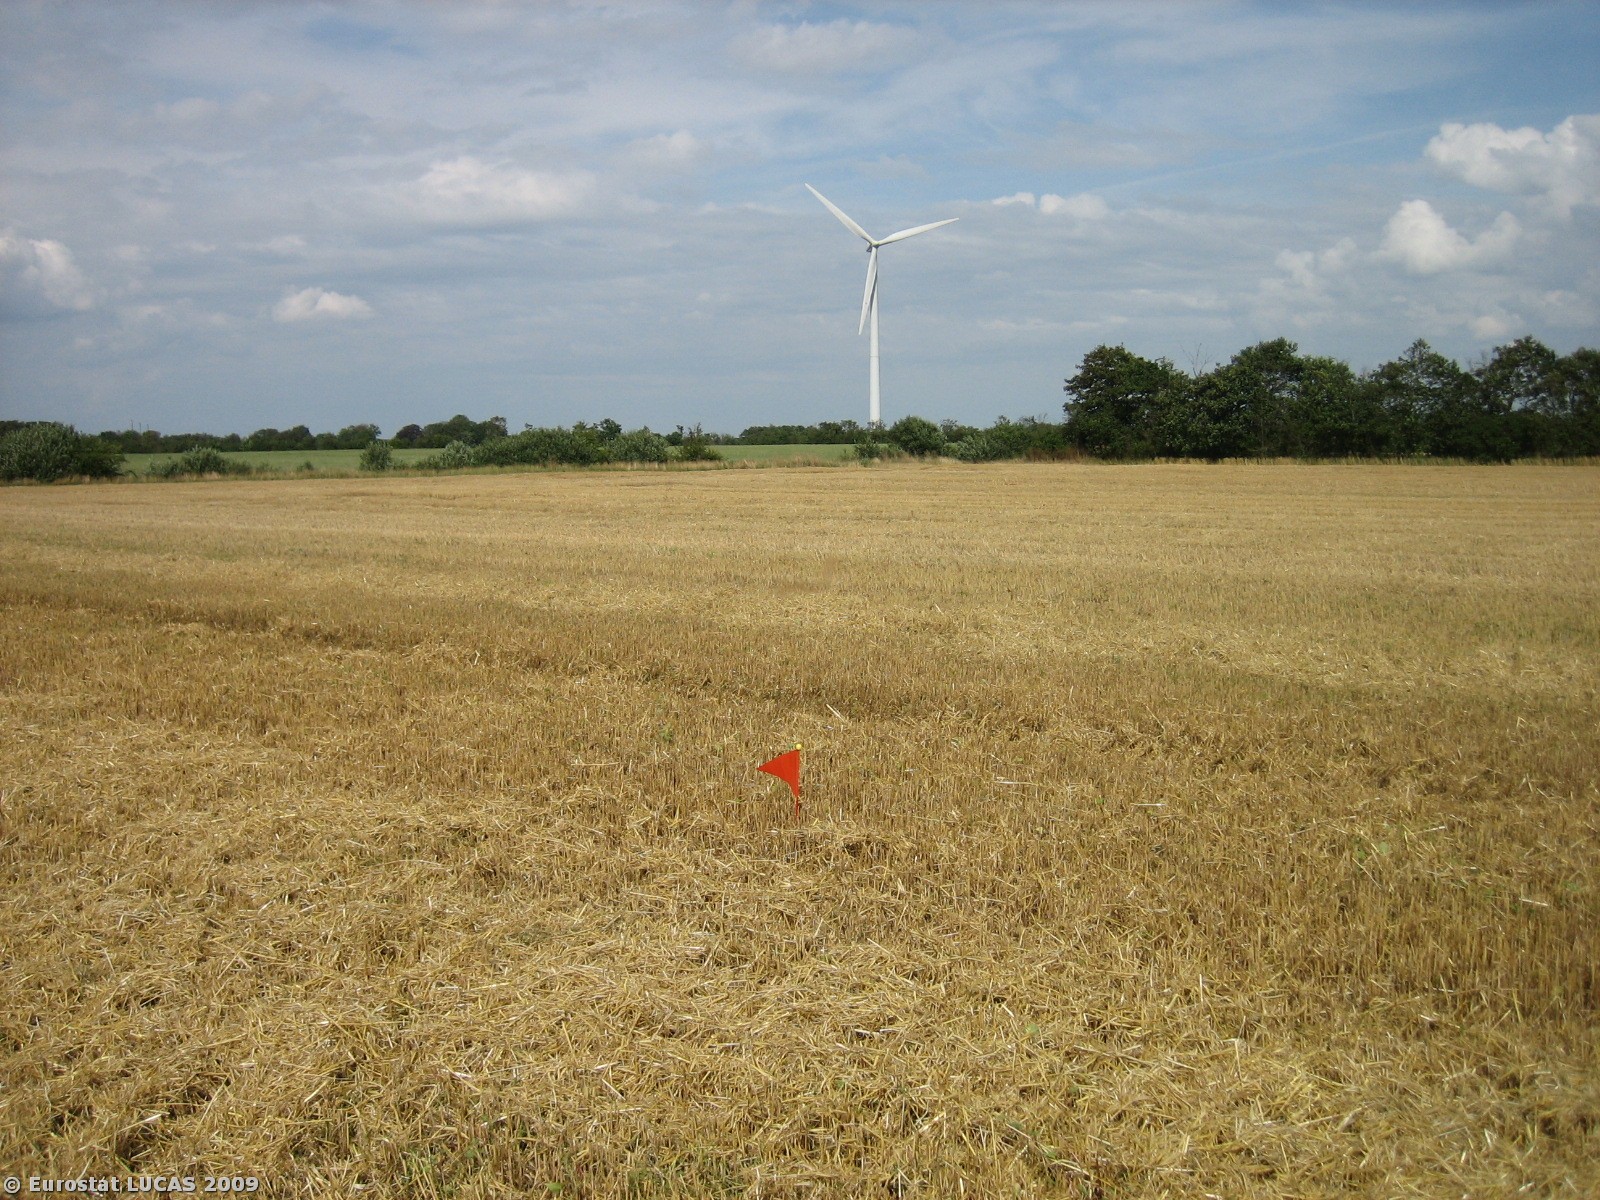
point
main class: Cropland
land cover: Barley
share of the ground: > 75 %
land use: Agriculture (excluding fallow land and kitchen gardens)
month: July
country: DK
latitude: 55.7687
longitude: 8.8057
